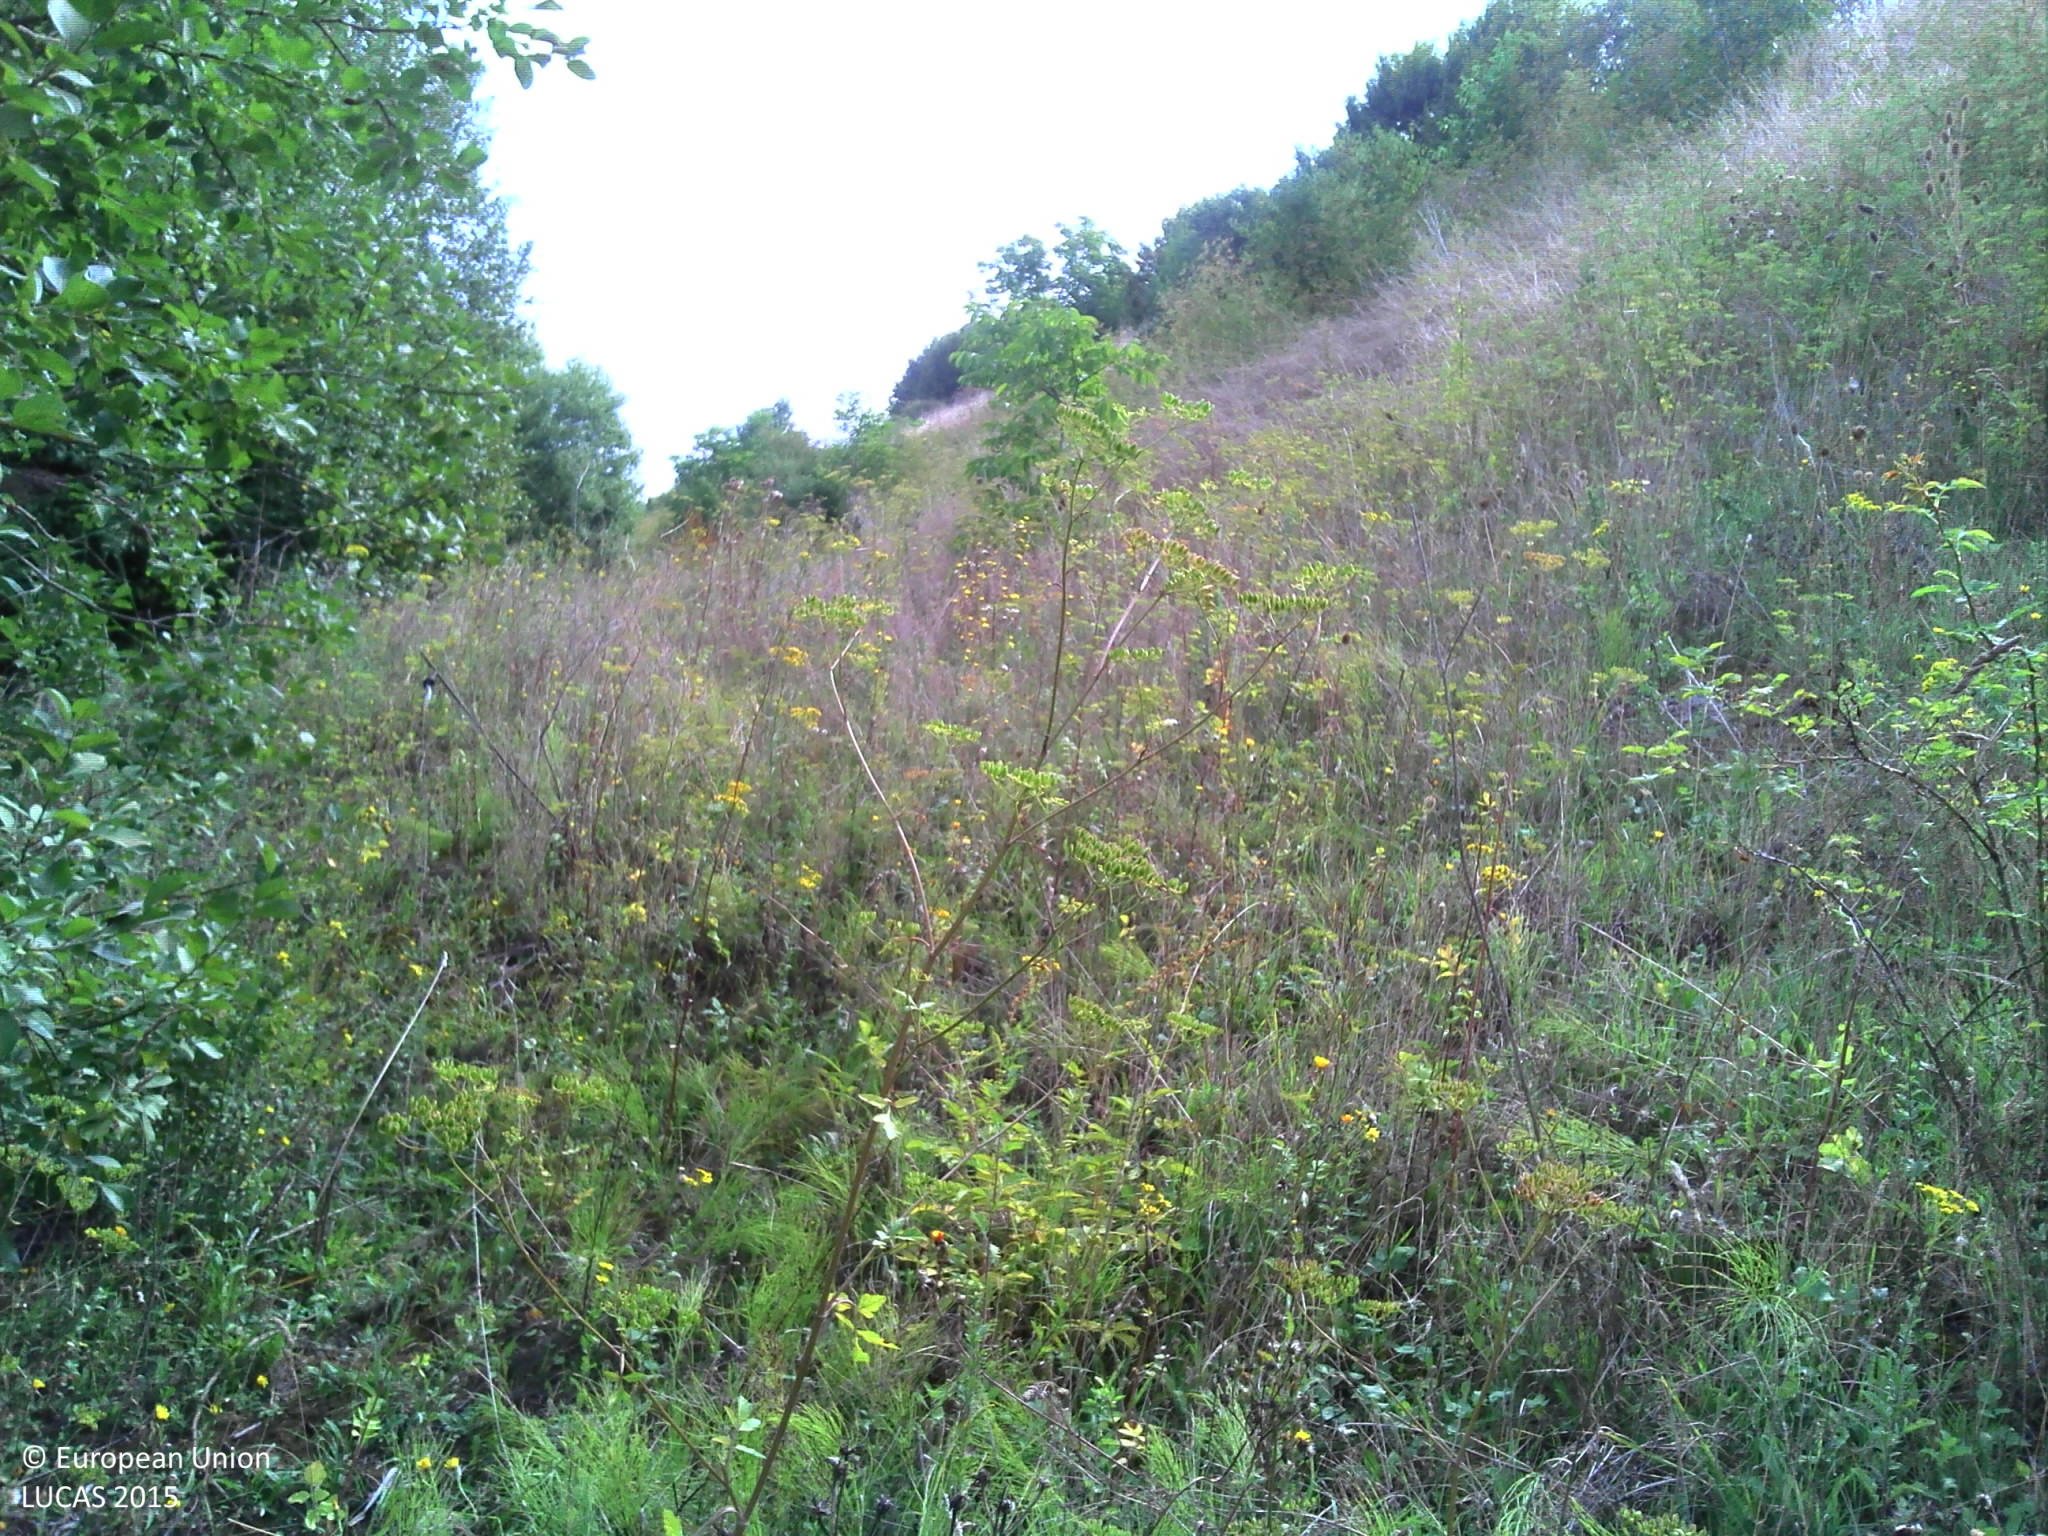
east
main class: Grassland
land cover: Spontaneously vegetated surfaces
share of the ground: > 75 %
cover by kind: herbaceous plants 95 %, shrubs 5 %
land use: Semi-natural and natural areas not in use
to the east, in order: Spontaneously vegetated surfaces; Ditches and canals; Spontaneously vegetated surfaces; Managed hedges; Ditches and canals; Spontaneously vegetated surfaces; Managed hedges; Fences; Grass margins; Common wheat; Grass margins; Tracks; Grass margins; Rape and turnip rape
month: September
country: FR
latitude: 48.5513
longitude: 6.1120
